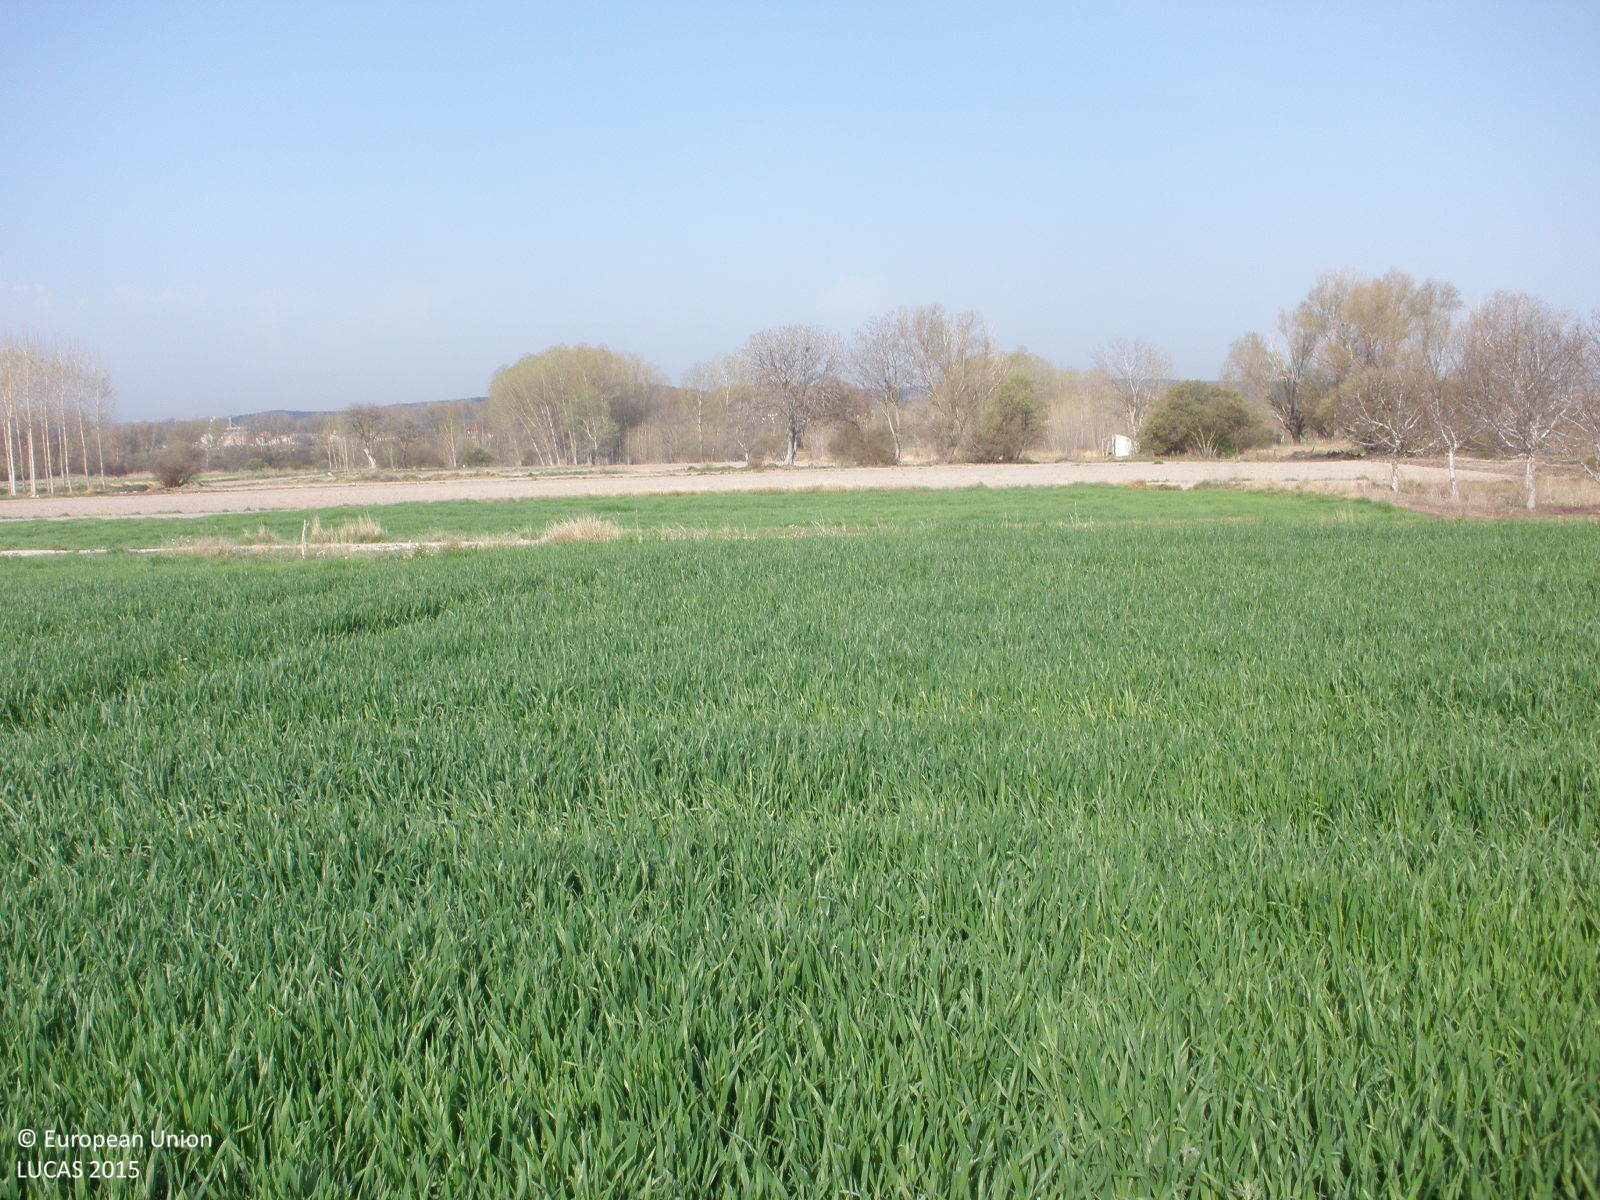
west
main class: Cropland
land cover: Common wheat
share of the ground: > 75 %
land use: Agriculture (excluding fallow land and kitchen gardens)
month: April
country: ES
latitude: 40.8505
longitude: -1.3217
